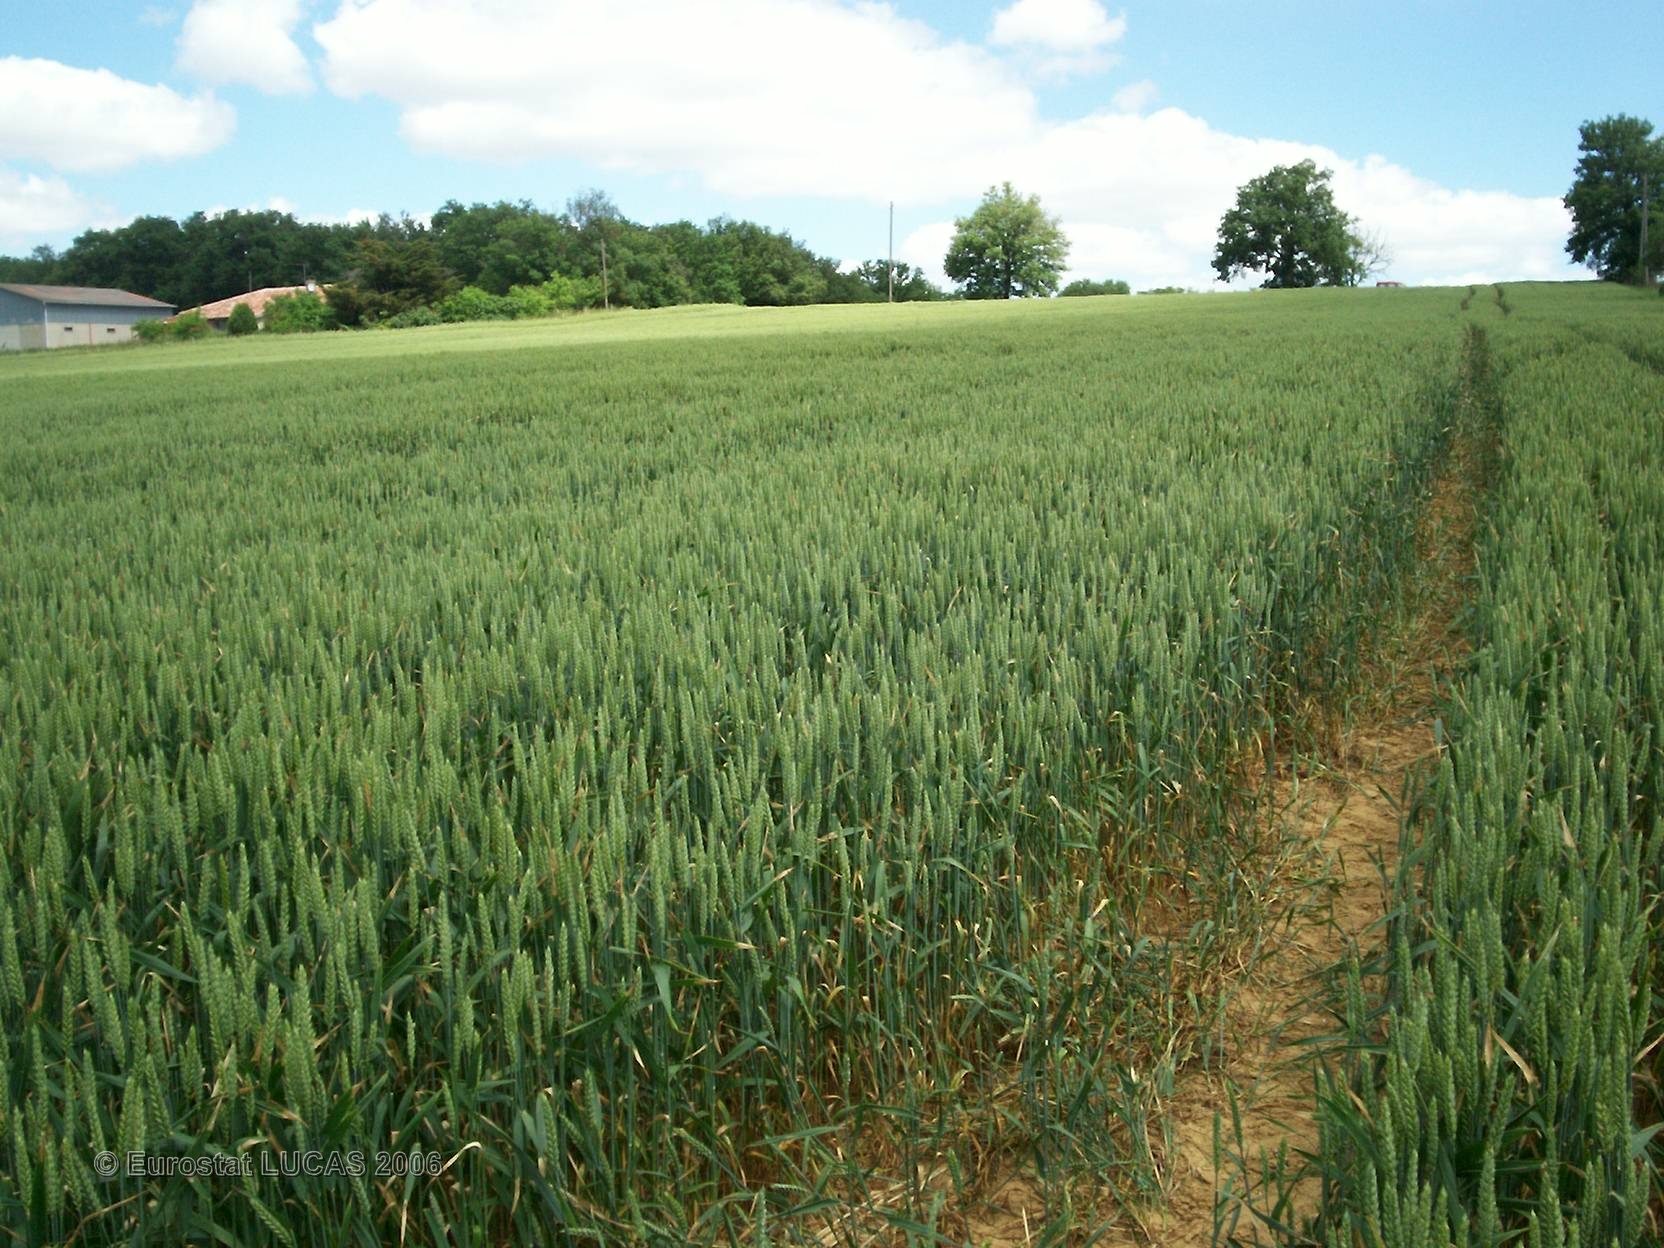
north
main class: Cropland
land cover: Common wheat
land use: Agriculture (excluding fallow land and kitchen gardens)
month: May
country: FR
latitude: 43.6492
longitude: 0.9866
